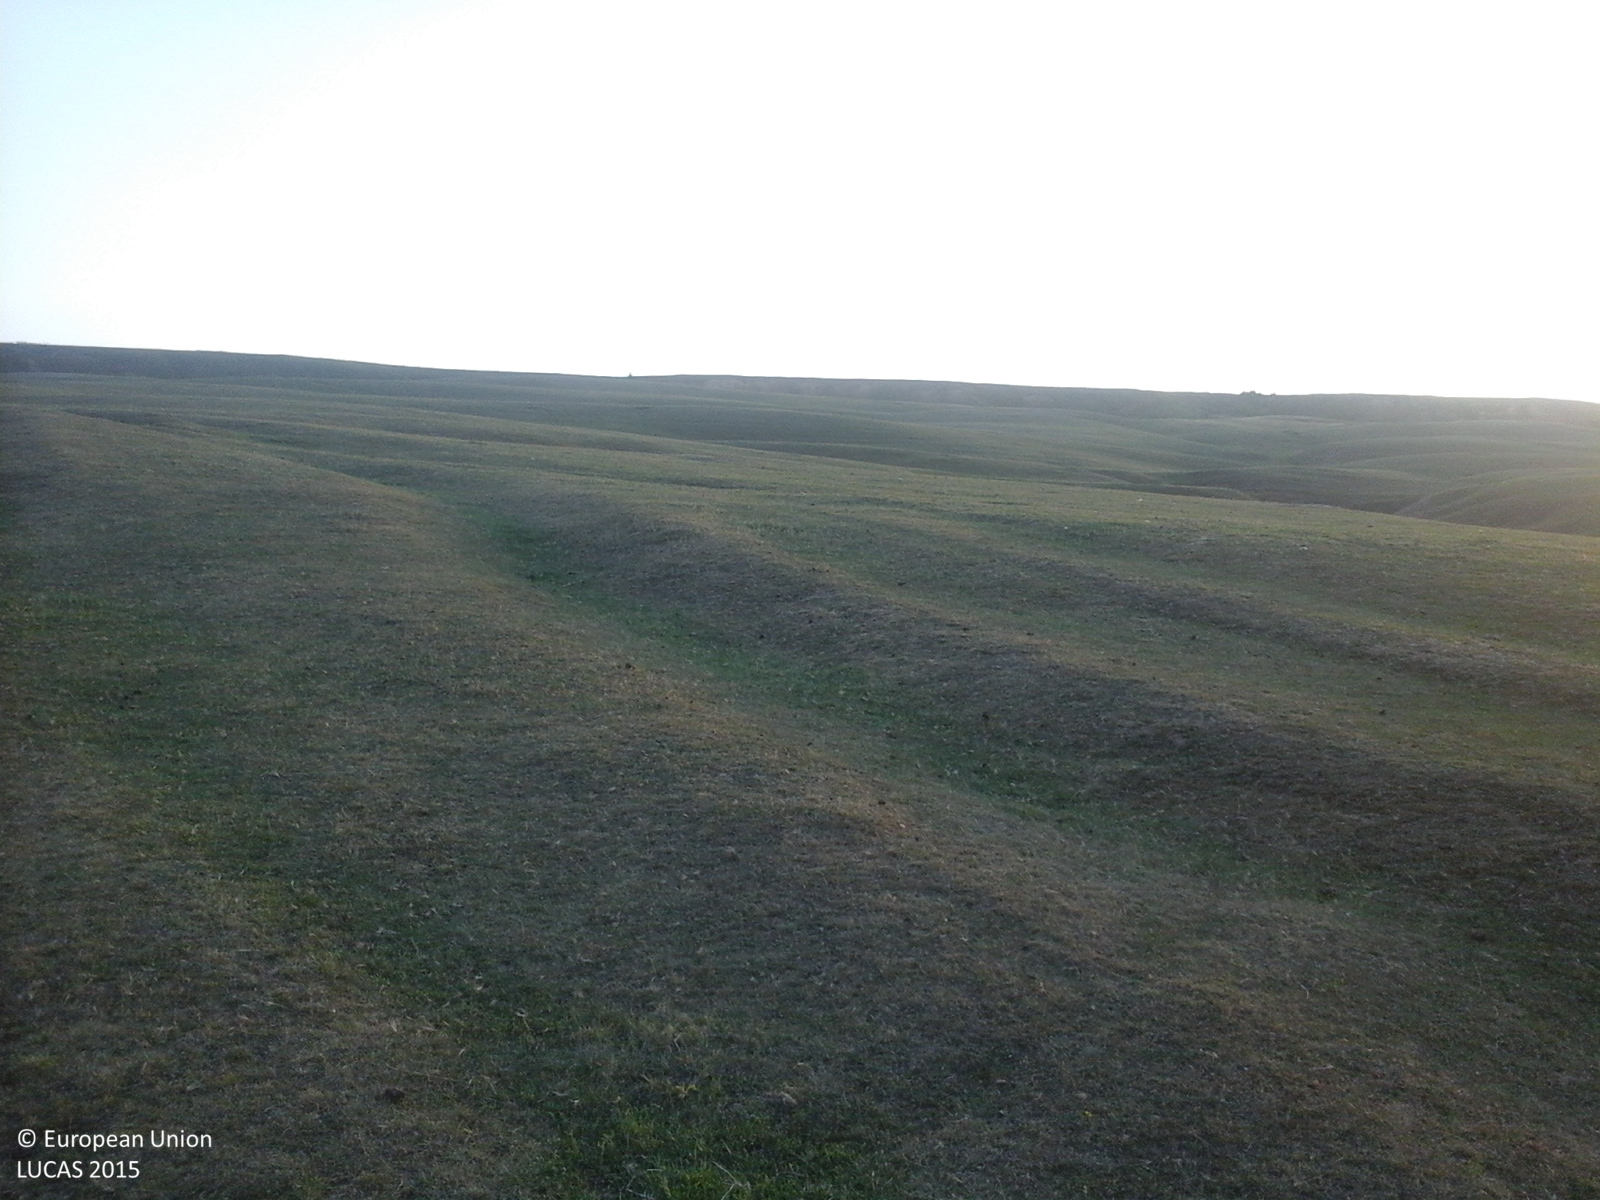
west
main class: Grassland
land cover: Grassland without tree/shrub cover
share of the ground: > 75 %
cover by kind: herbaceous plants 100 %
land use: Agriculture (excluding fallow land and kitchen gardens)
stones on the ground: < 10 %
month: June
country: RO
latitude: 46.9467
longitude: 27.3331
